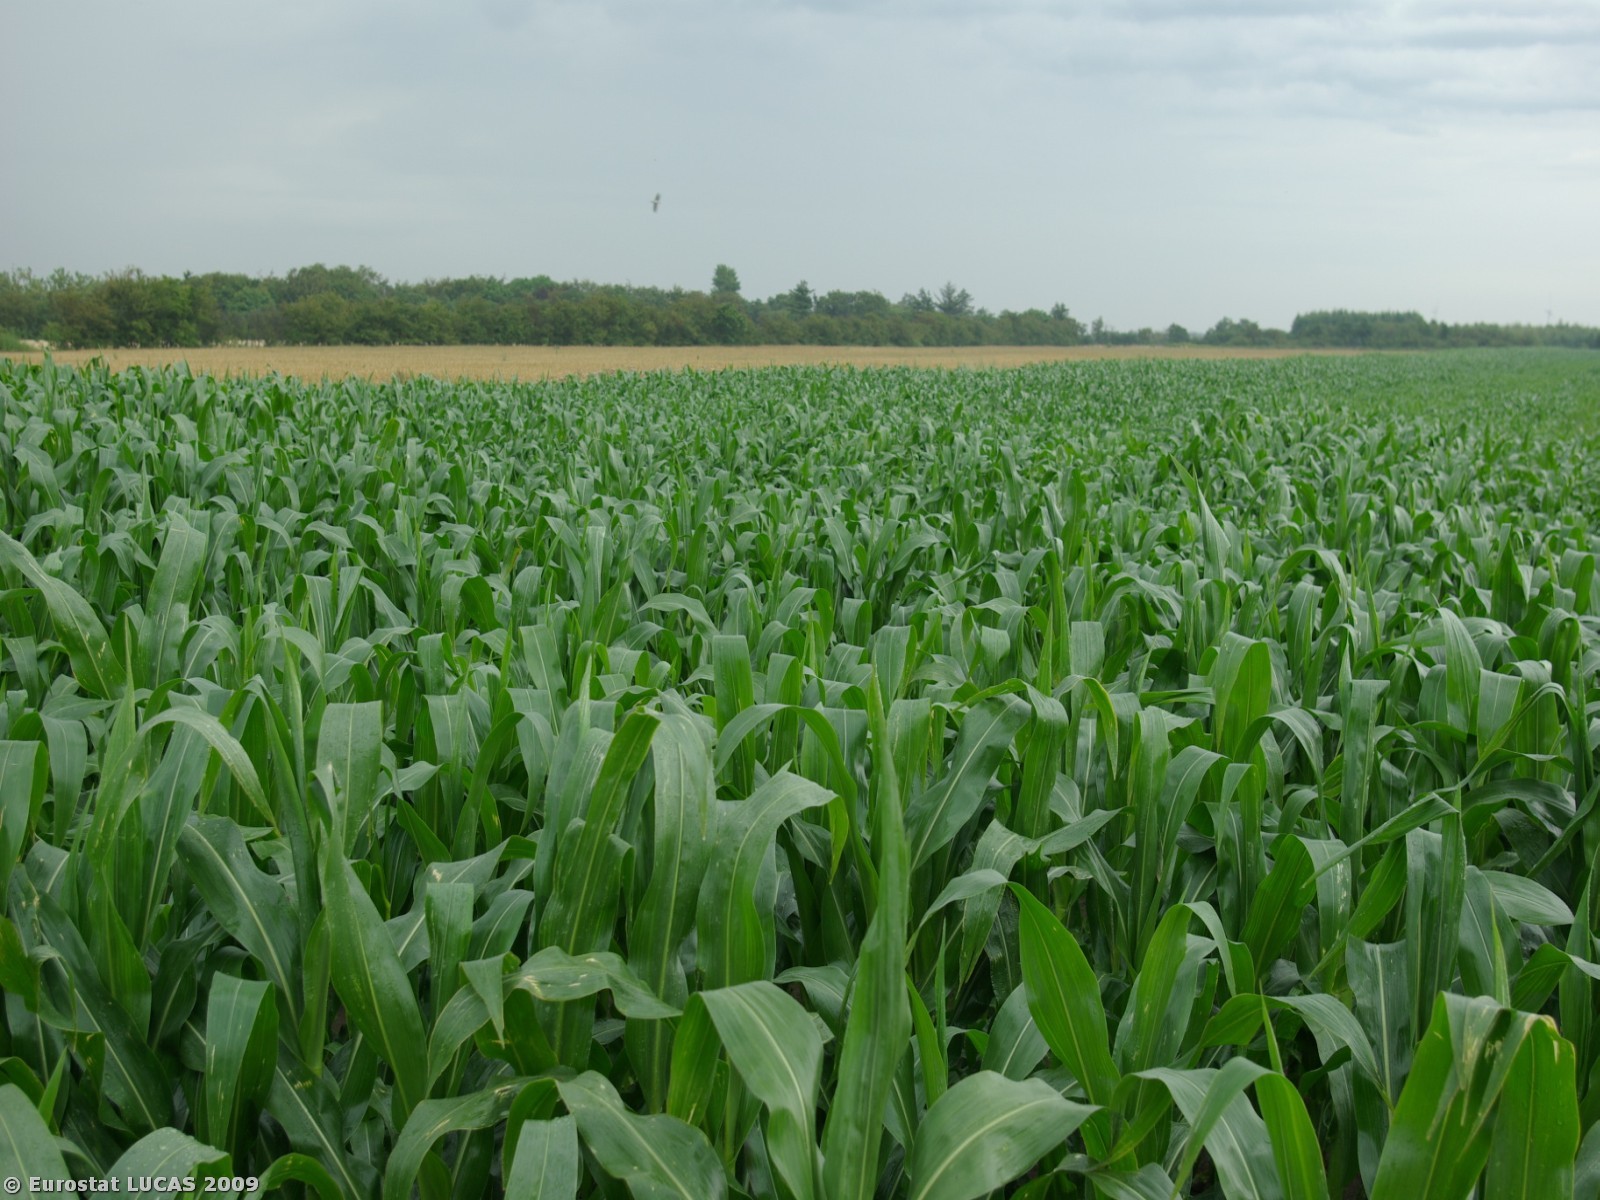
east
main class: Cropland
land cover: Maize
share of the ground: > 75 %
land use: Agriculture (excluding fallow land and kitchen gardens)
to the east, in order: Maize; Grass margins; Common wheat
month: July
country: DK
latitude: 55.2287
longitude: 8.7275
